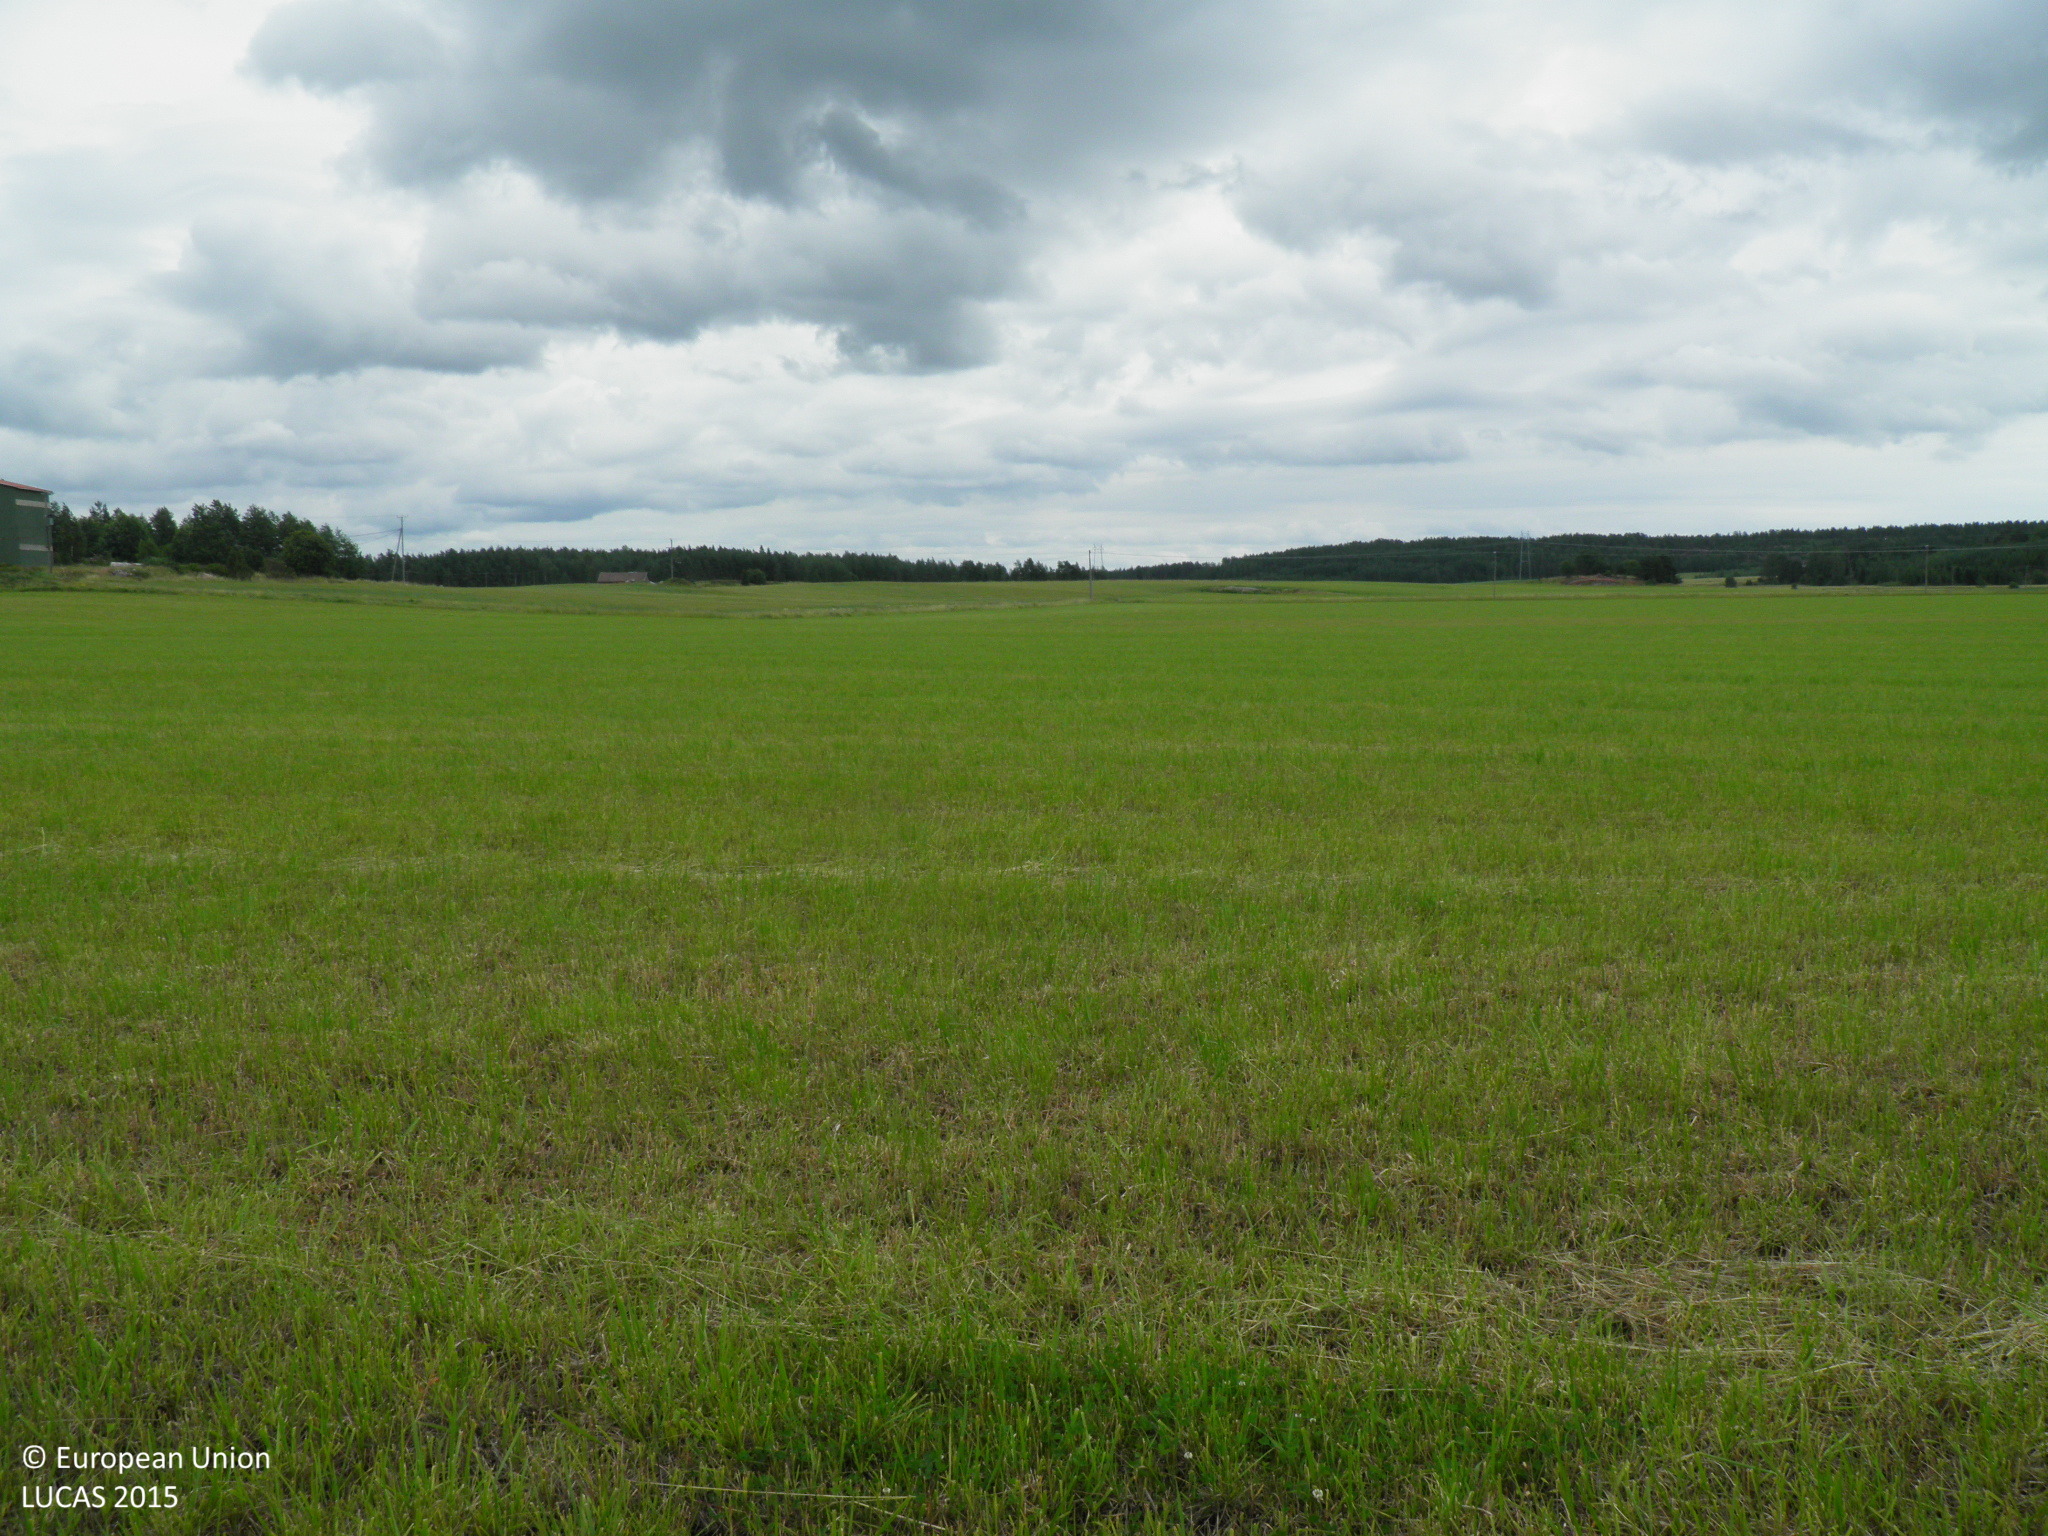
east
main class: Cropland
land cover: Temporary grasslands
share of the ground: > 75 %
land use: Agriculture (excluding fallow land and kitchen gardens)
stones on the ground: < 10 %
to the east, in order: Temporary grasslands
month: July
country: FI
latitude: 60.1868
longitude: 22.7159
